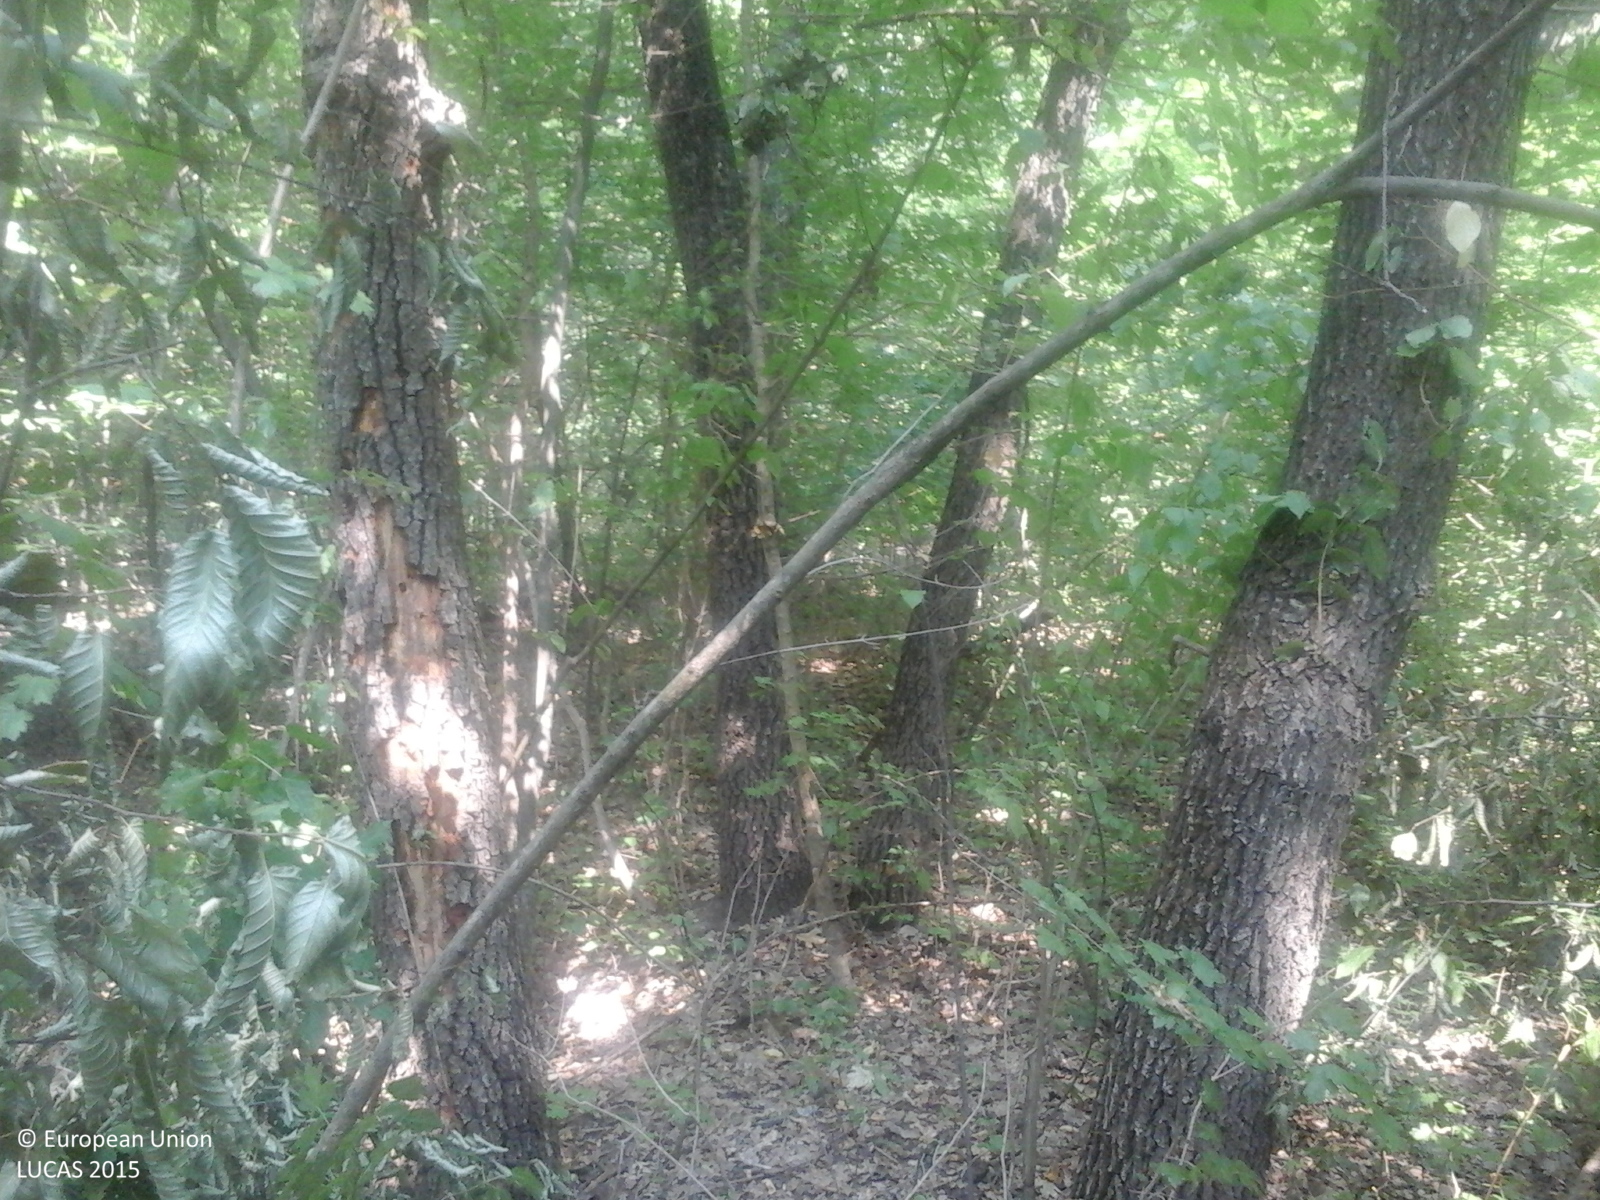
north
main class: Woodland
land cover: Broadleaved woodland
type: acidophilous oak and oak-birch forest
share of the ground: > 75 %
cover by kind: broadleaved forest trees 100 %
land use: Forestry
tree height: > 5 m
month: July
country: RO
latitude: 46.3910
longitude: 27.5770
